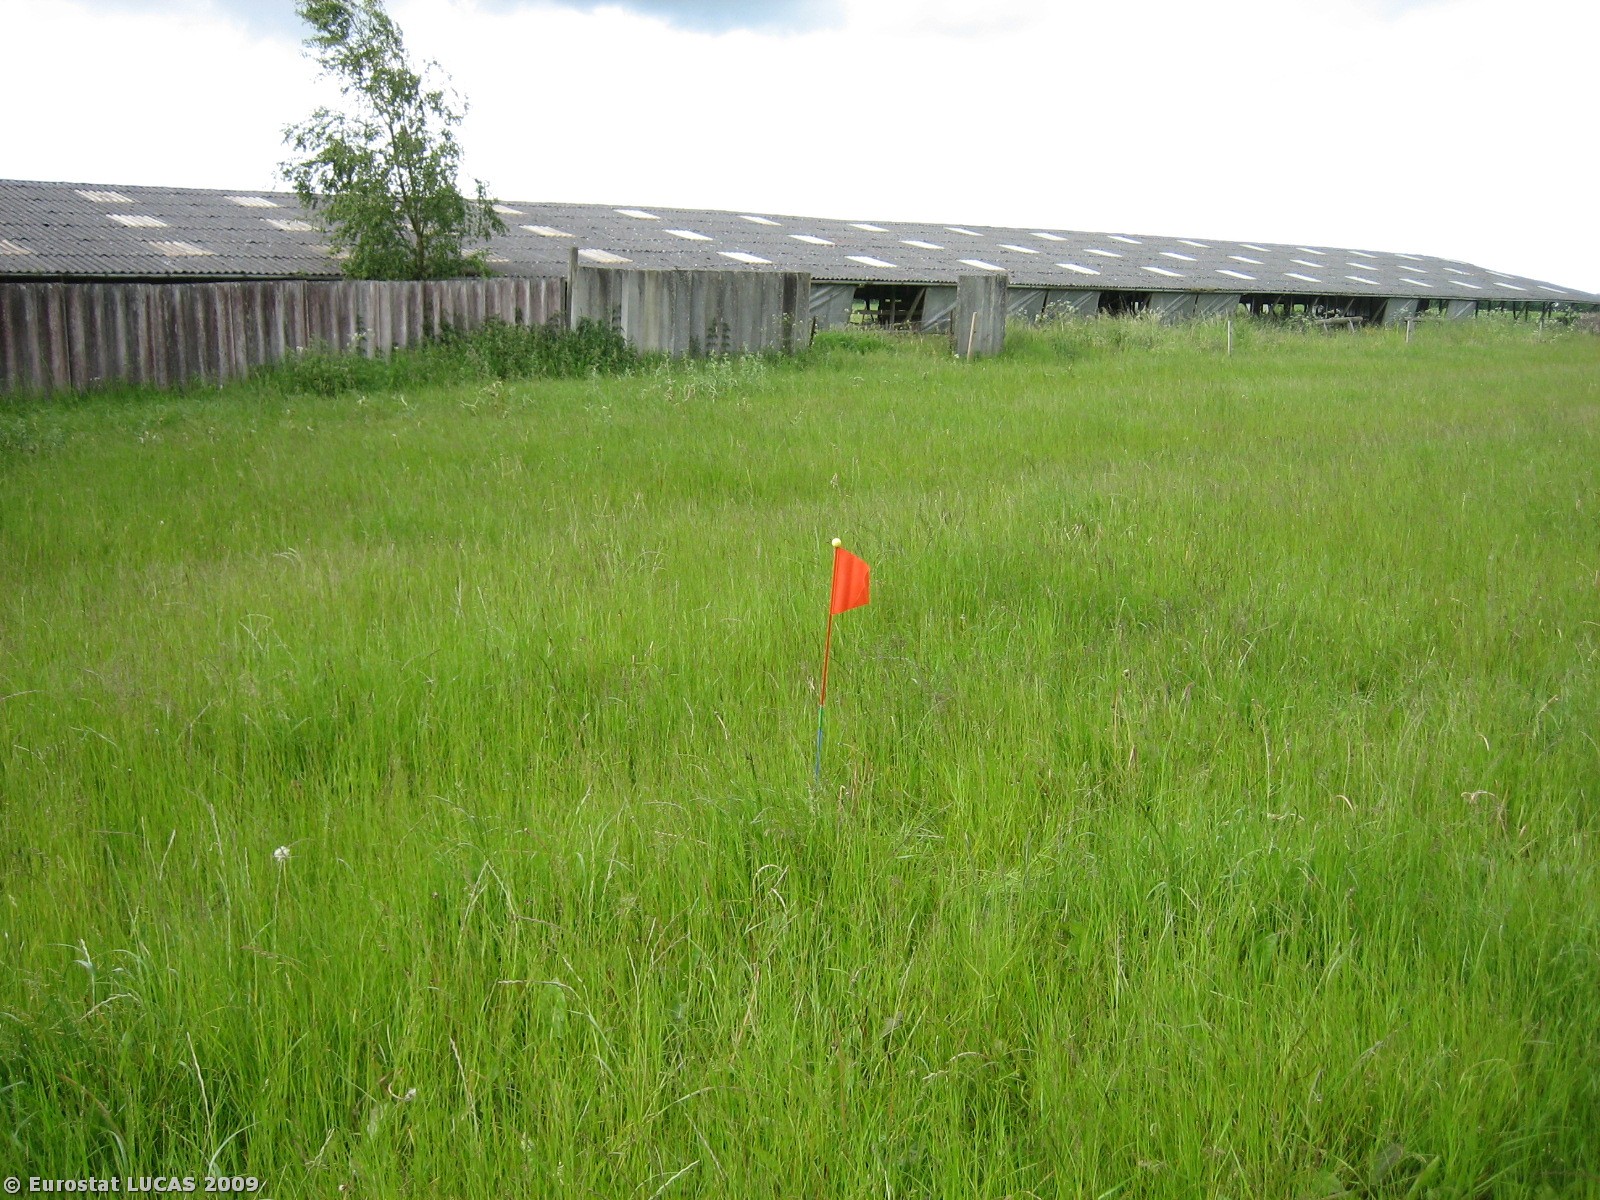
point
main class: Grassland
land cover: Grassland without tree/shrub cover
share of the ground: > 75 %
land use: Agriculture (excluding fallow land and kitchen gardens)
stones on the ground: < 10 %
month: June
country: DK
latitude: 56.2775
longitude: 9.8548
